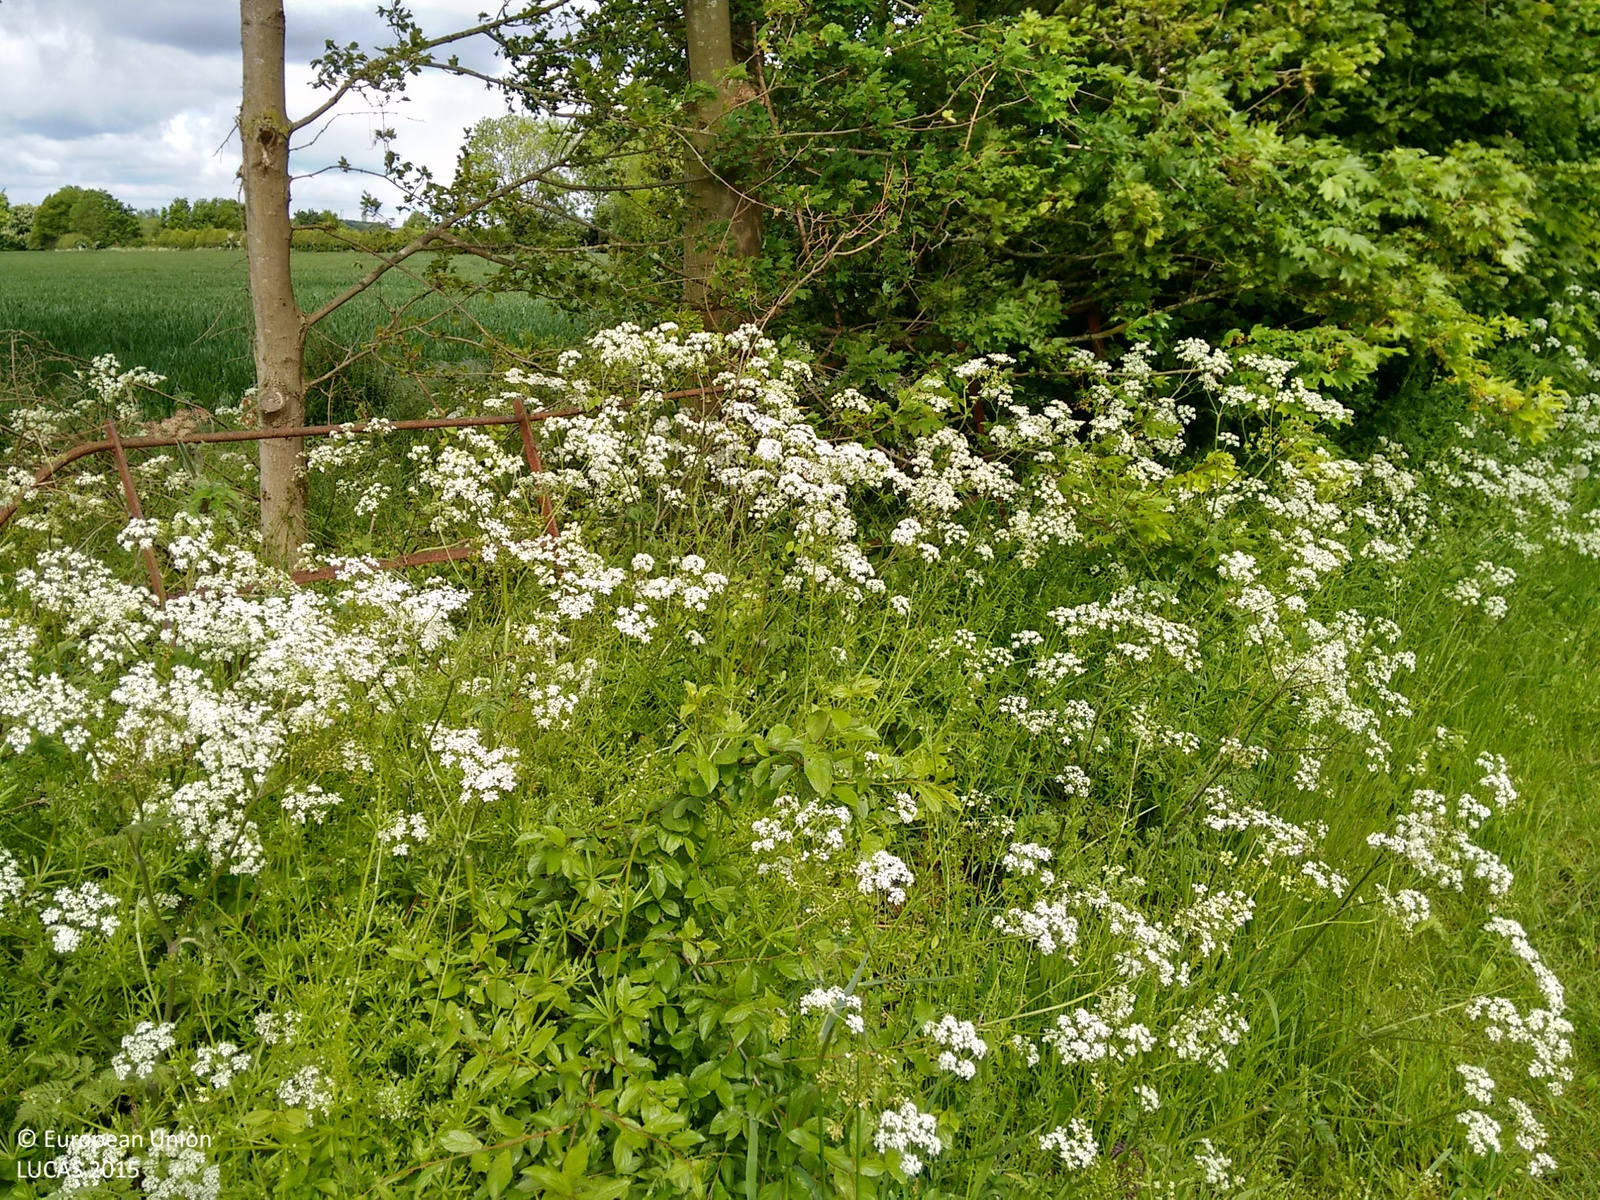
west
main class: Cropland
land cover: Barley
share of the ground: > 75 %
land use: Agriculture (excluding fallow land and kitchen gardens)
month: May
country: GB
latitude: 52.2971
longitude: -1.4139
